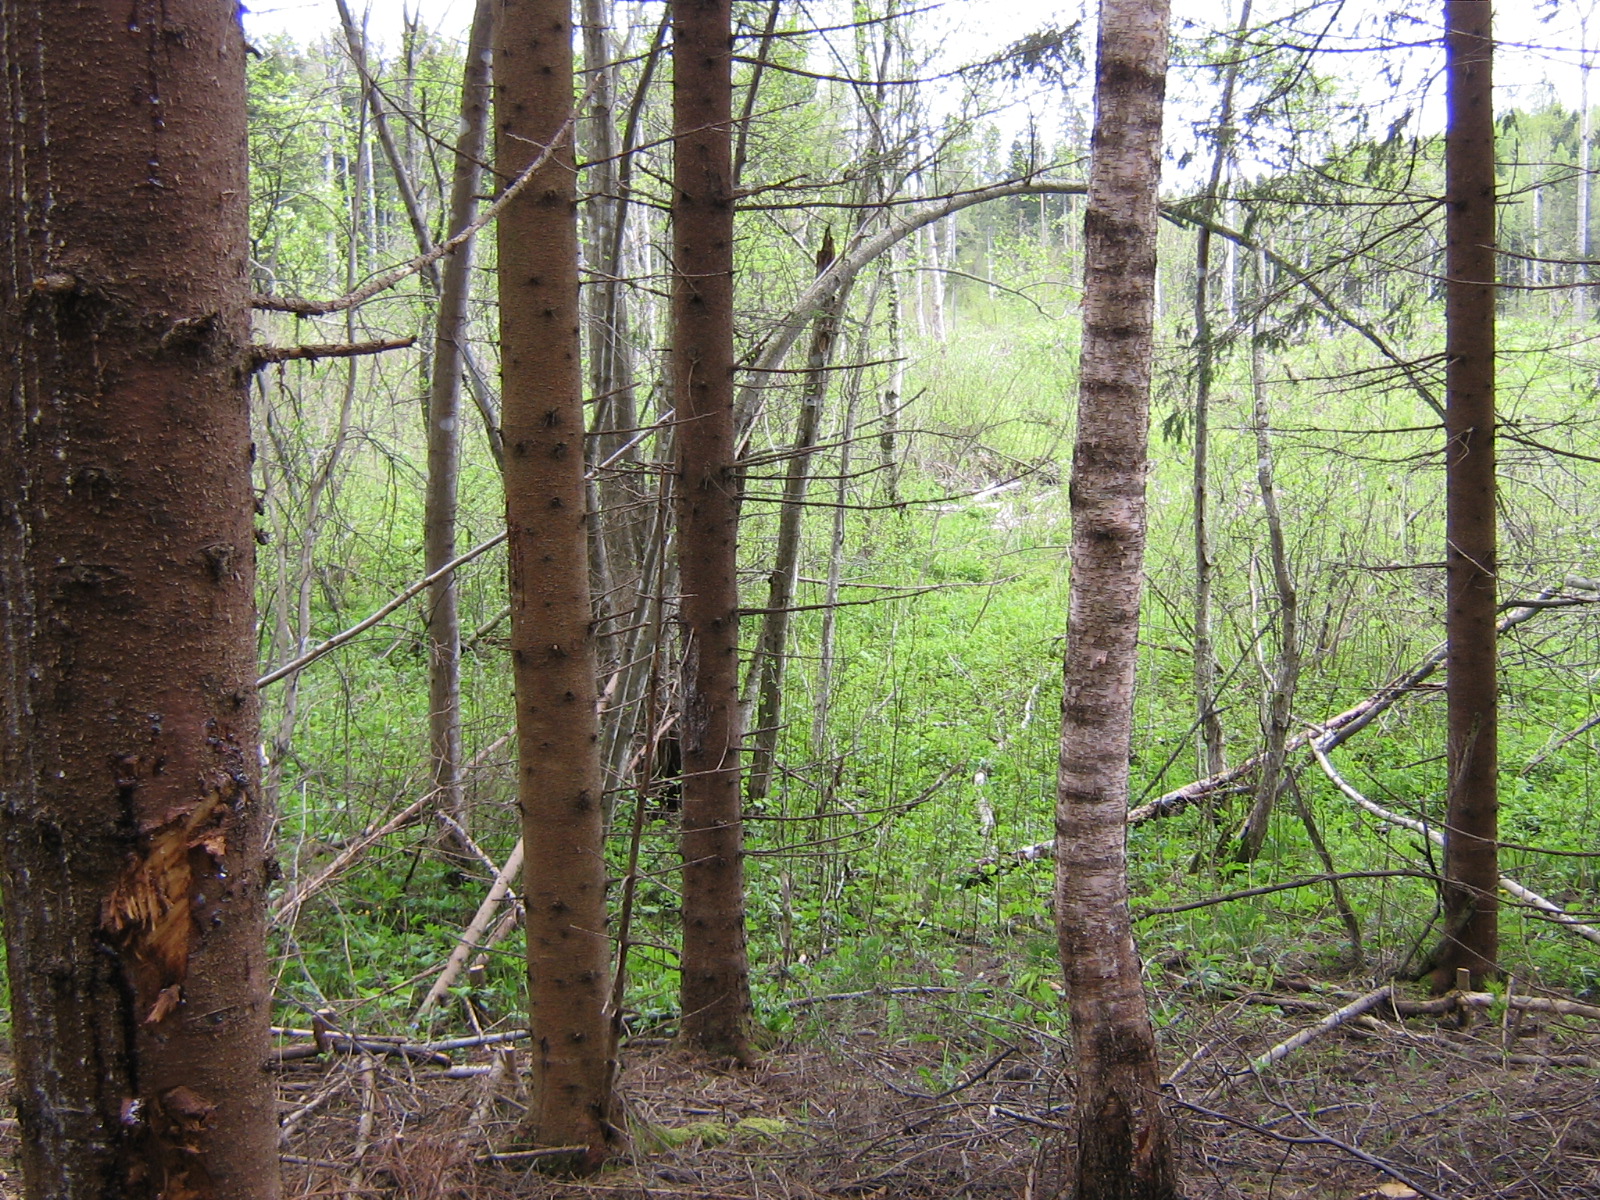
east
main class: Woodland
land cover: Spruce dominated mixed woodland
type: hemiboreal forest and nemoral coniferous forest and mixed broadleaved-coniferous forest
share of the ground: > 75 %
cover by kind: coniferous forest trees 70 %, broadleaved forest trees 30 %
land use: Forestry
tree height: > 5 m
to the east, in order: Spruce dominated mixed woodland; Broadleaved woodland; Spruce dominated mixed woodland
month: May
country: LV
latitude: 57.1811
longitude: 25.5190
